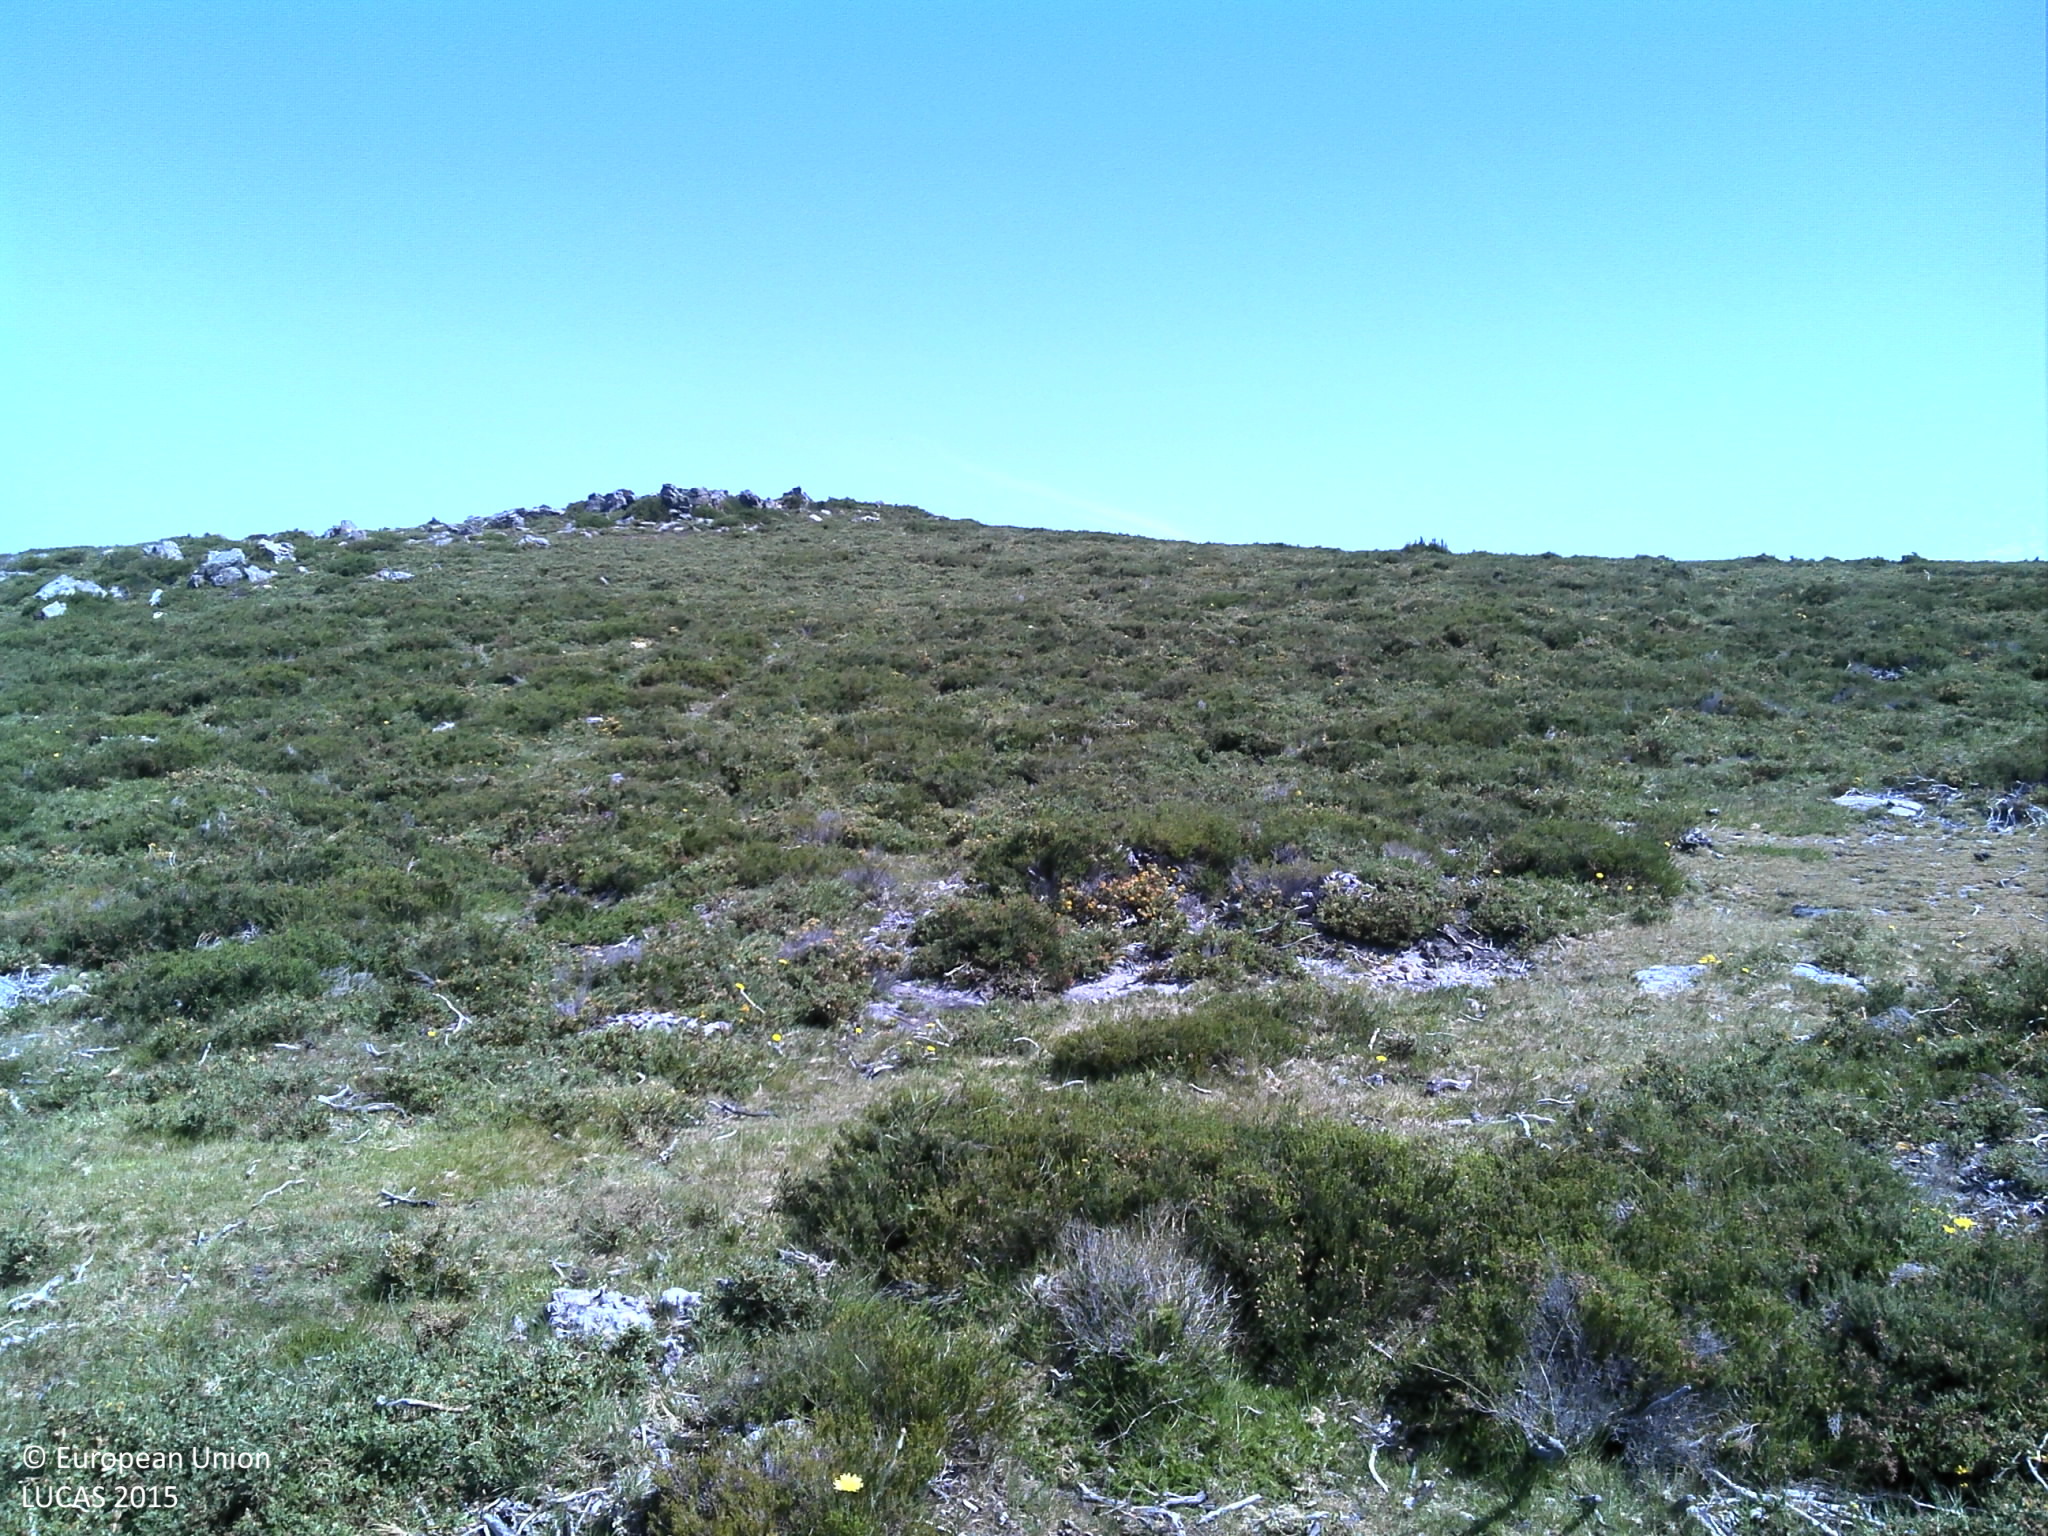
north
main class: Shrubland
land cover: Shrubland without tree cover
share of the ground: 50 - 75 %
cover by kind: shrubs 70 %, herbaceous plants 20 %, consolidated bare surface 5 %, unconsolidated bare surface 5 %
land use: Agriculture (excluding fallow land and kitchen gardens)
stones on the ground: < 10 %
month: June
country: PT
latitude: 41.9642
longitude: -8.3167
